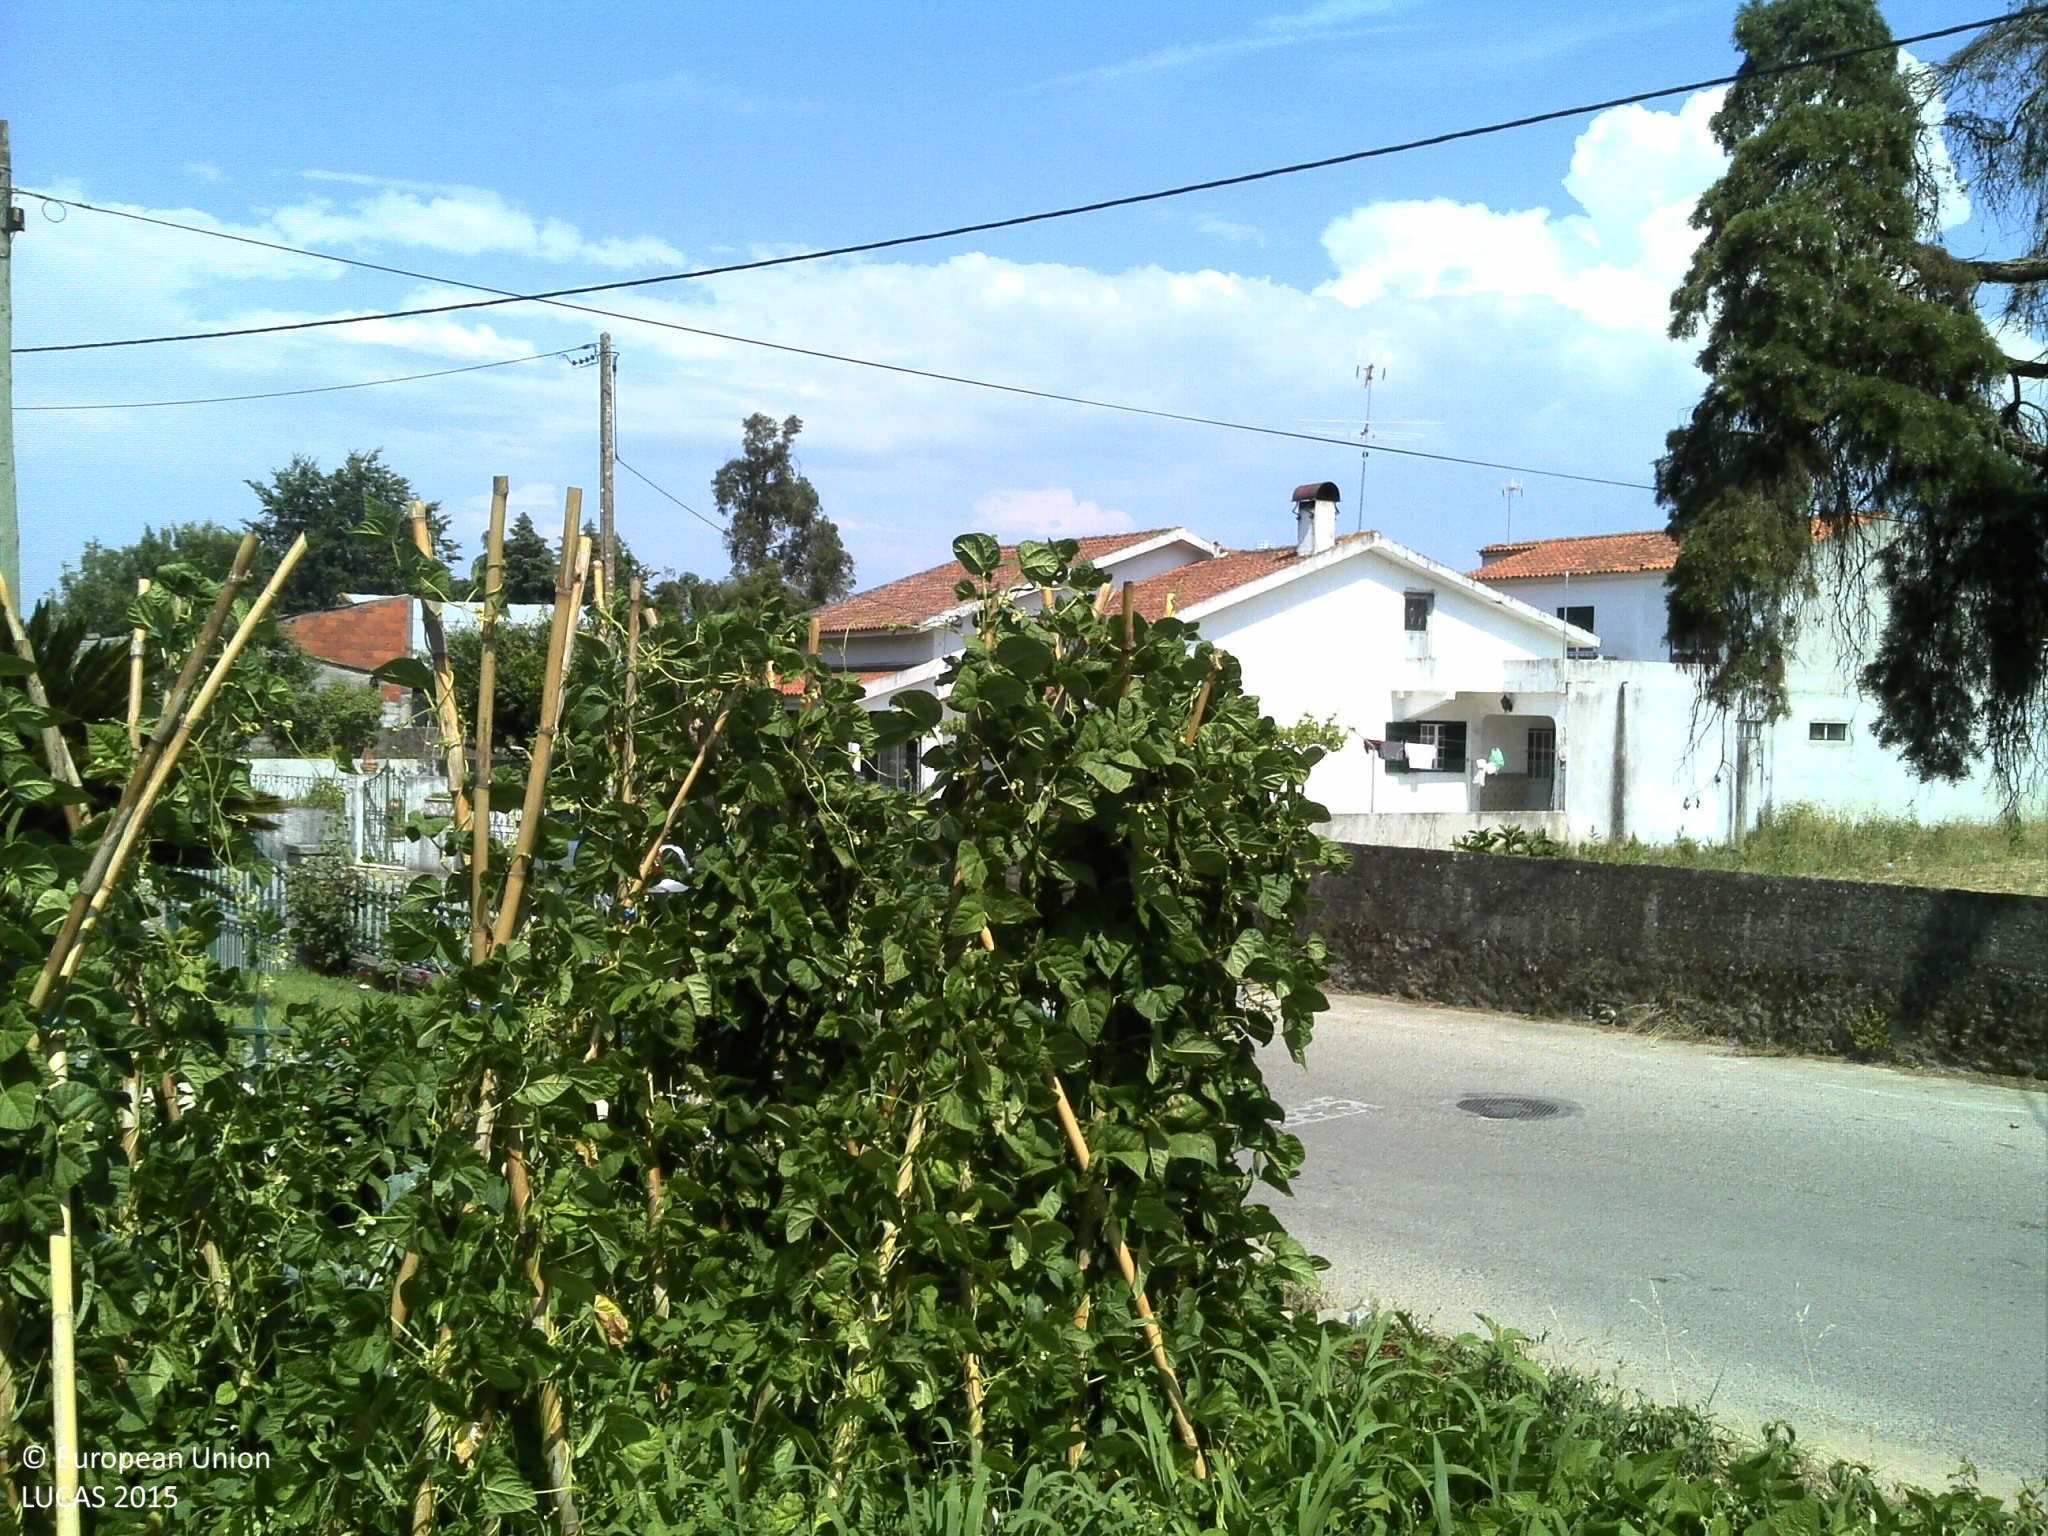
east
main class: Cropland
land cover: Potatoes
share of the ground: > 75 %
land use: Kitchen garden
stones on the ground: < 10 %
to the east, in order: Potatoes; Tomatoes; Artificial constructions in urban areas; Spontaneously vegetated surfaces; Artificial constructions in urban areas; Pine dominated coniferous woodland; Other citrus fruit; Tracks; Fences; Grassland without tree/shrub cover; Fences; Broadleaved woodland; Rivers and streams; Shruby margins; Spontaneously vegetated surfaces
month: June
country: PT
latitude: 40.2203
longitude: -8.5481
